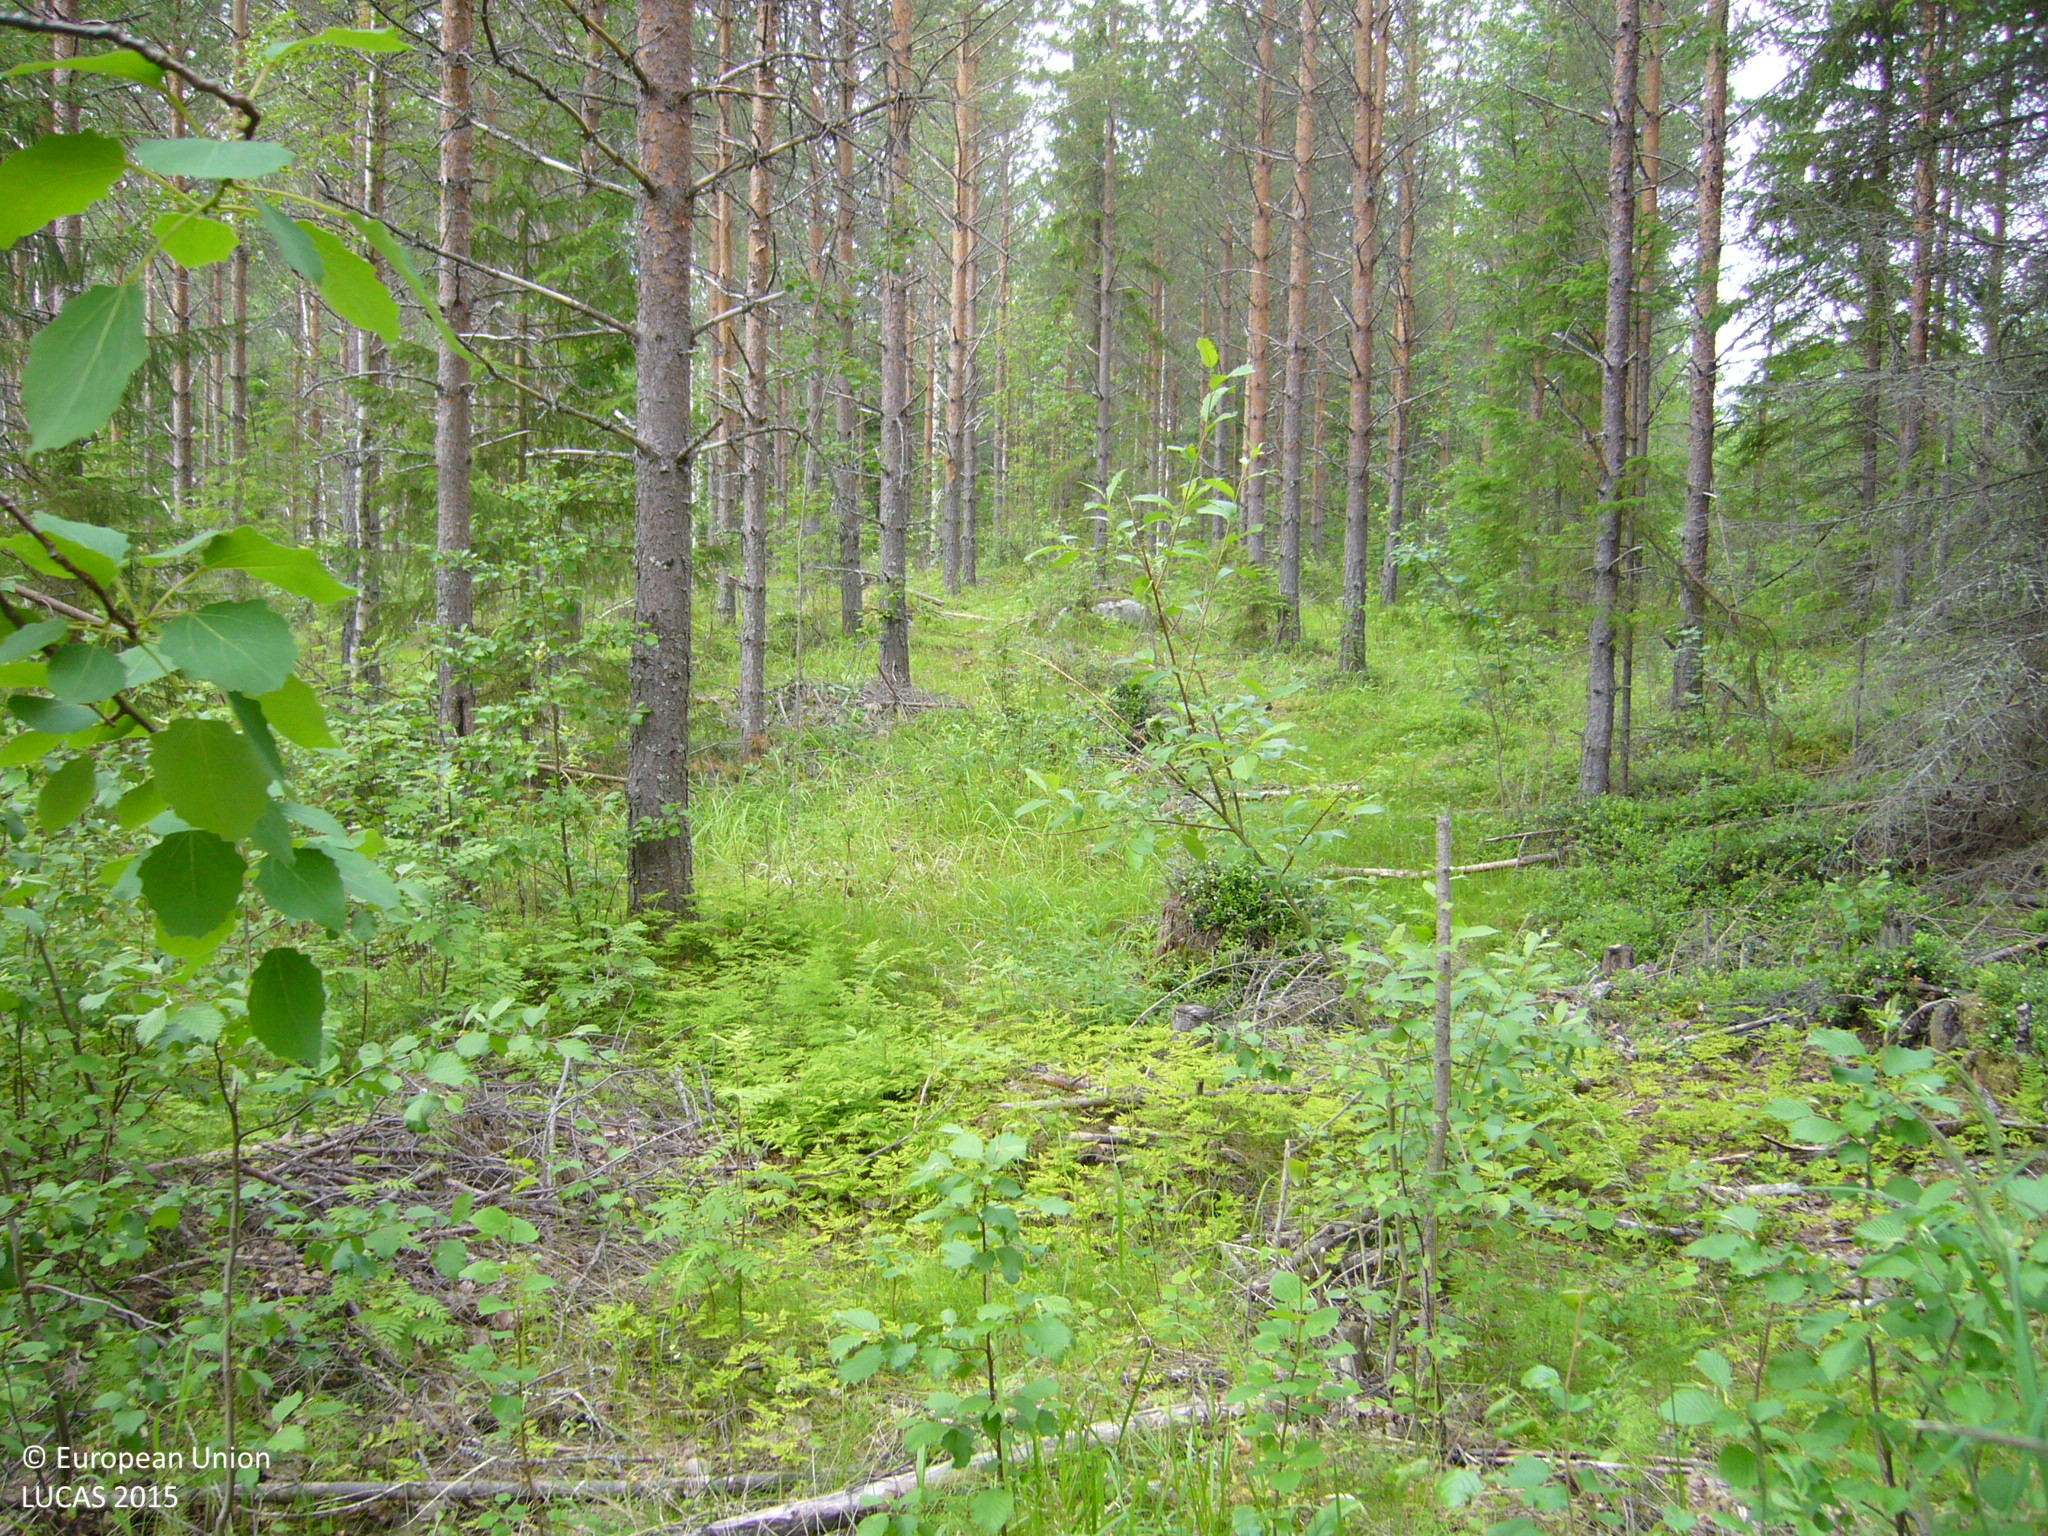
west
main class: Woodland
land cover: Pine dominated mixed woodland
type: boreal forest
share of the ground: > 75 %
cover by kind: coniferous forest trees 50 %, broadleaved forest trees 25 %, shrubs 25 %
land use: Forestry
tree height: > 5 m
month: July
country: FI
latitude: 63.1861
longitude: 26.0339
